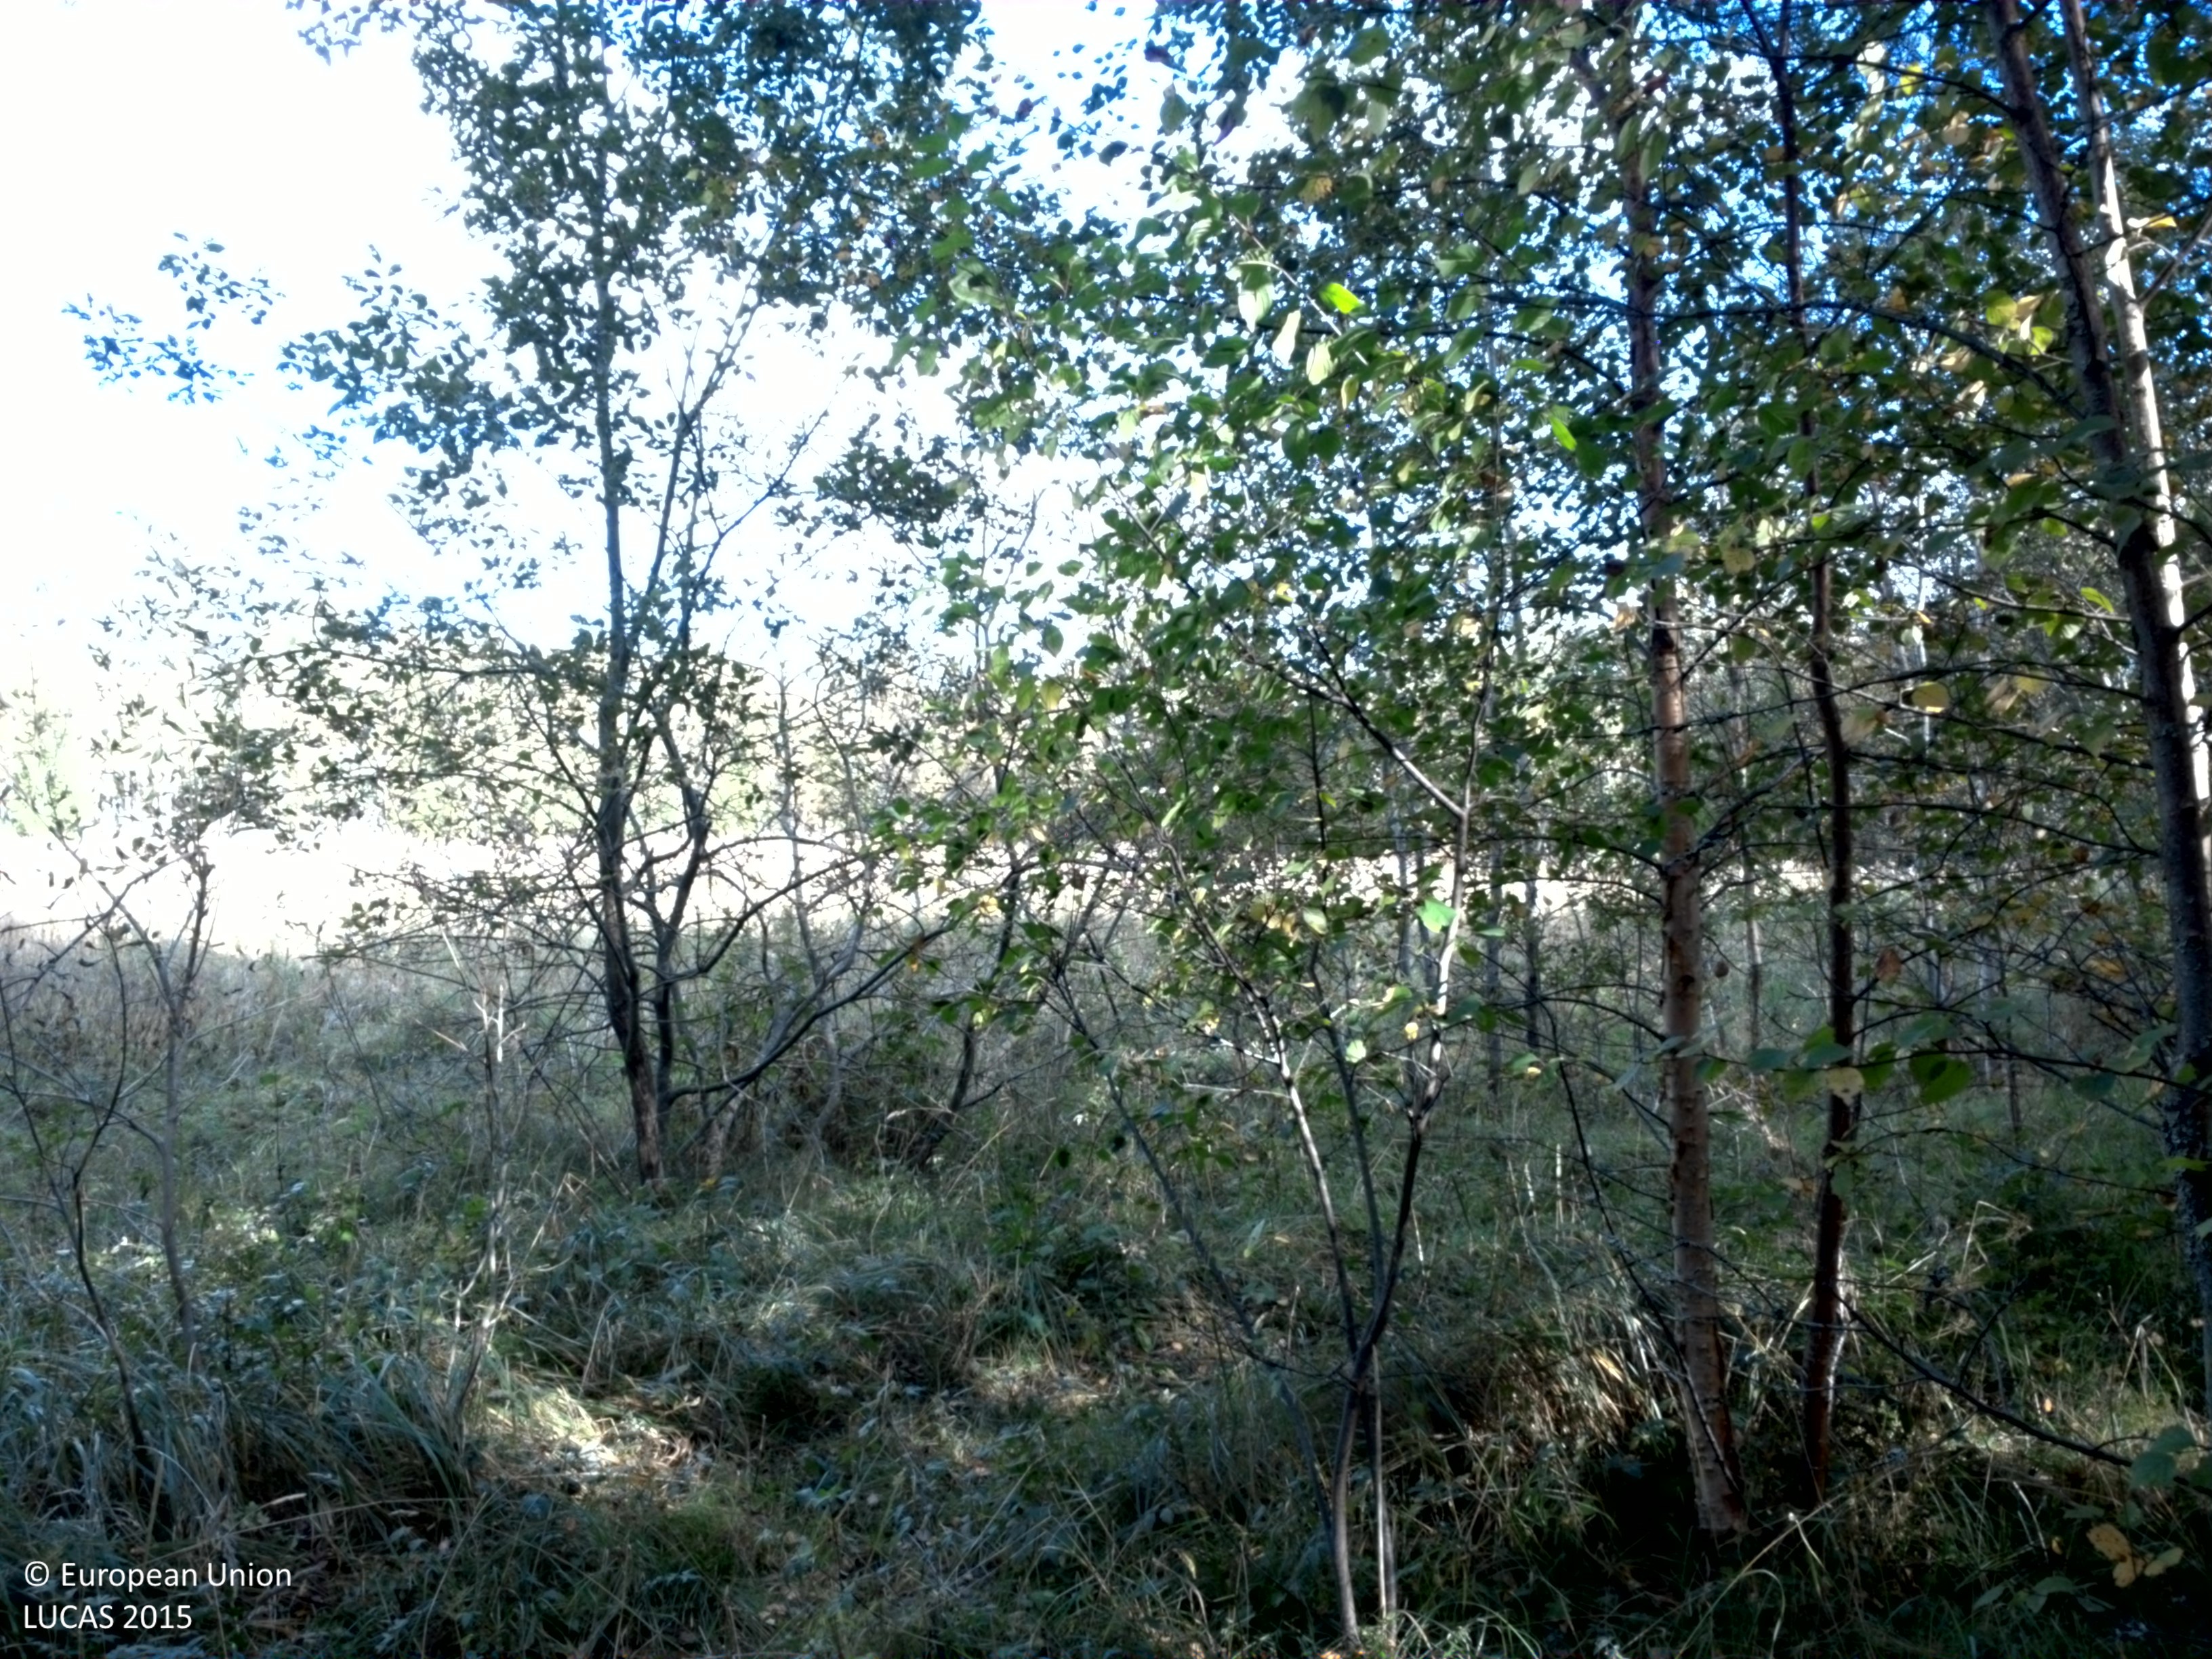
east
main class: Woodland
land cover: Pine dominated coniferous woodland
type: boreal forest
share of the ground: 50 - 75 %
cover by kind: coniferous forest trees 50 %, herbaceous plants 40 %, broadleaved forest trees 10 %
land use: Forestry
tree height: > 5 m
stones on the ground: < 10 %
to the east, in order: Pine dominated coniferous woodland; Tracks; Broadleaved woodland; Ditches and canals; Temporary grasslands; Ditches and canals; Spruce dominated coniferous woodland; Broadleaved woodland; Grassland without tree/shrub cover; Broadleaved woodland; Spruce dominated mixed woodland; Spruce dominated coniferous woodland; Other coniferous woodland
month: September
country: SE
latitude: 59.8465
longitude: 18.8708
